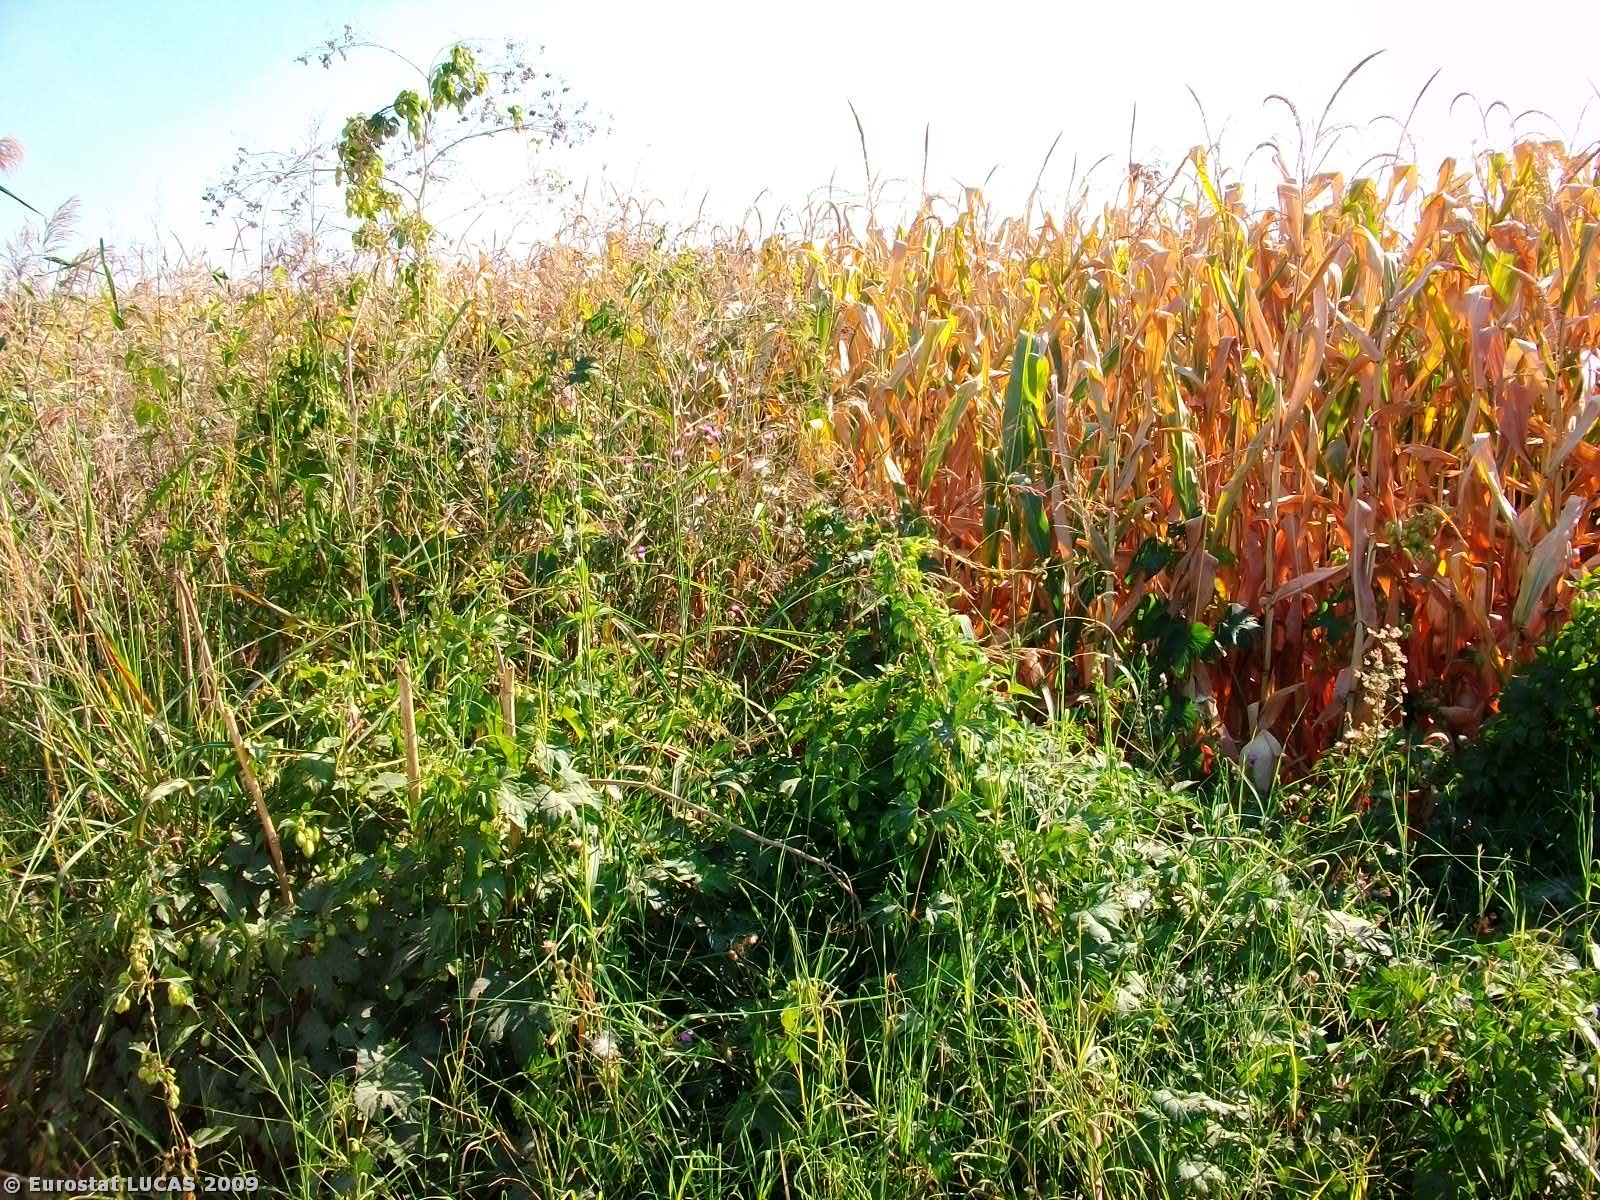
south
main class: Cropland
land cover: Maize
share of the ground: > 75 %
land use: Agriculture (excluding fallow land and kitchen gardens)
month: September
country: GR
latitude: 41.5898
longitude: 26.5764
